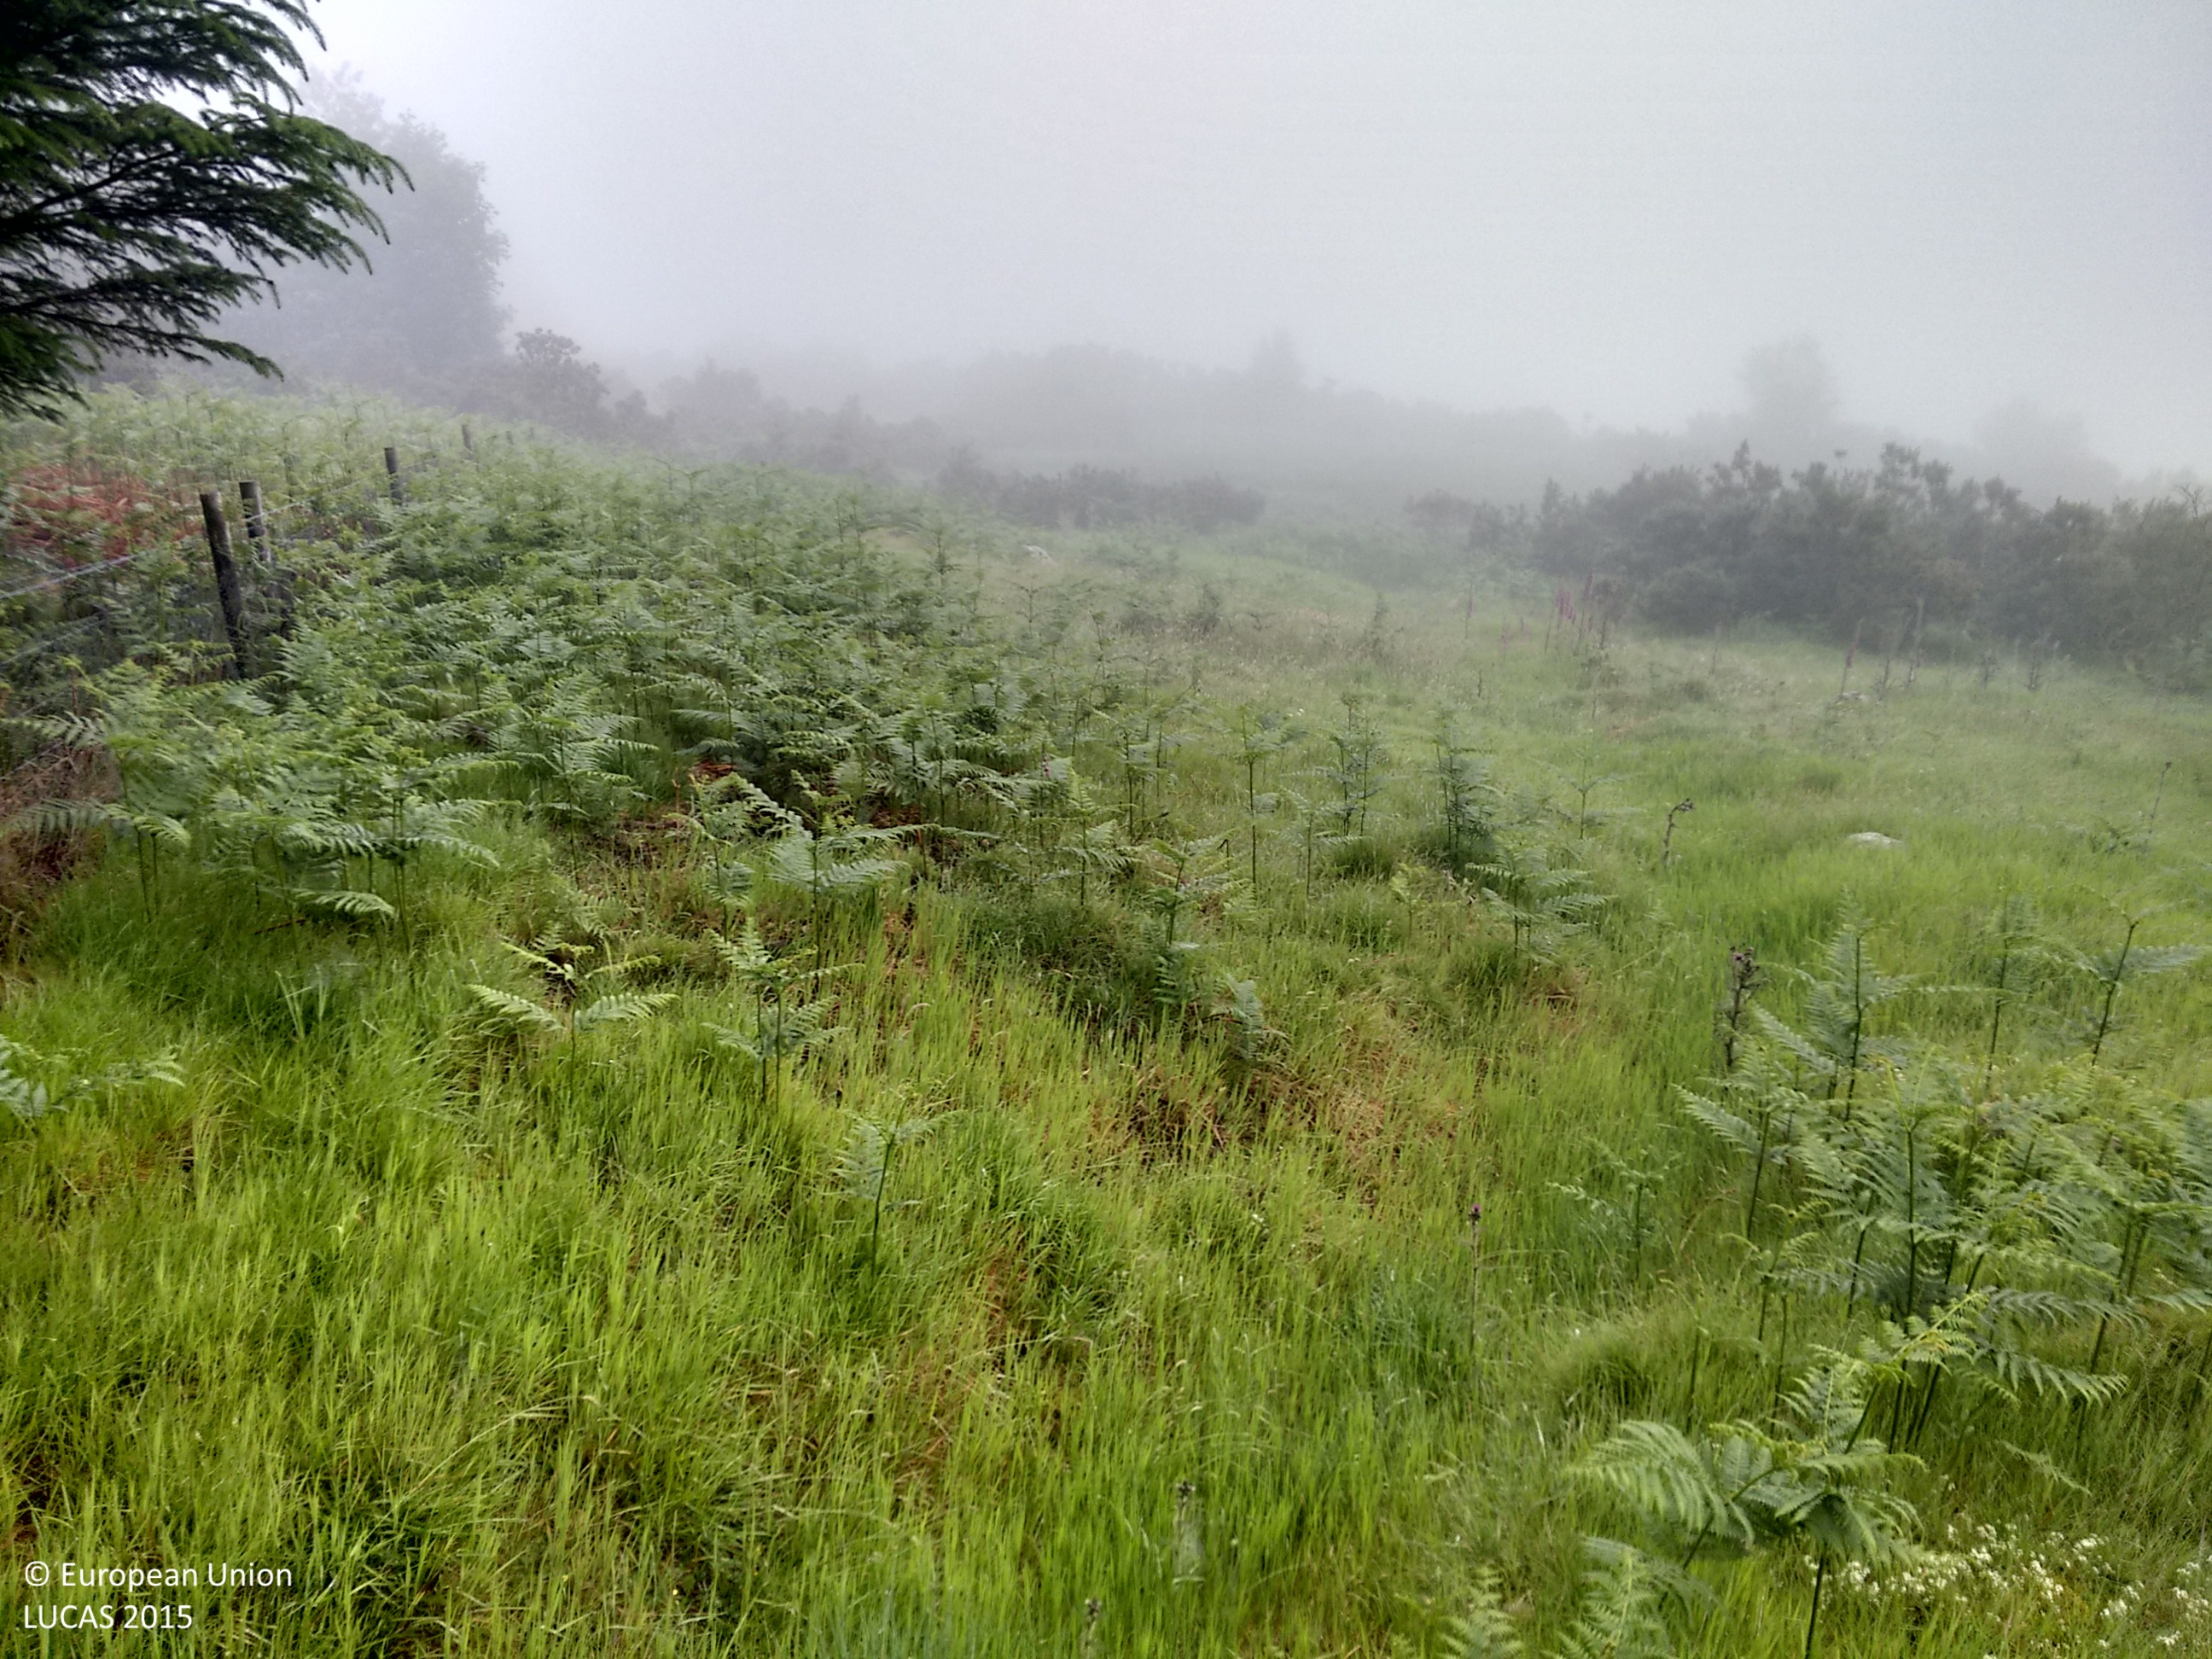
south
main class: Woodland
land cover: Spruce dominated coniferous woodland
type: exotic forest
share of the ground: > 75 %
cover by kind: coniferous forest trees 100 %
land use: Forestry
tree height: > 5 m
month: July
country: GB
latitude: 54.9214
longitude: -3.6740
